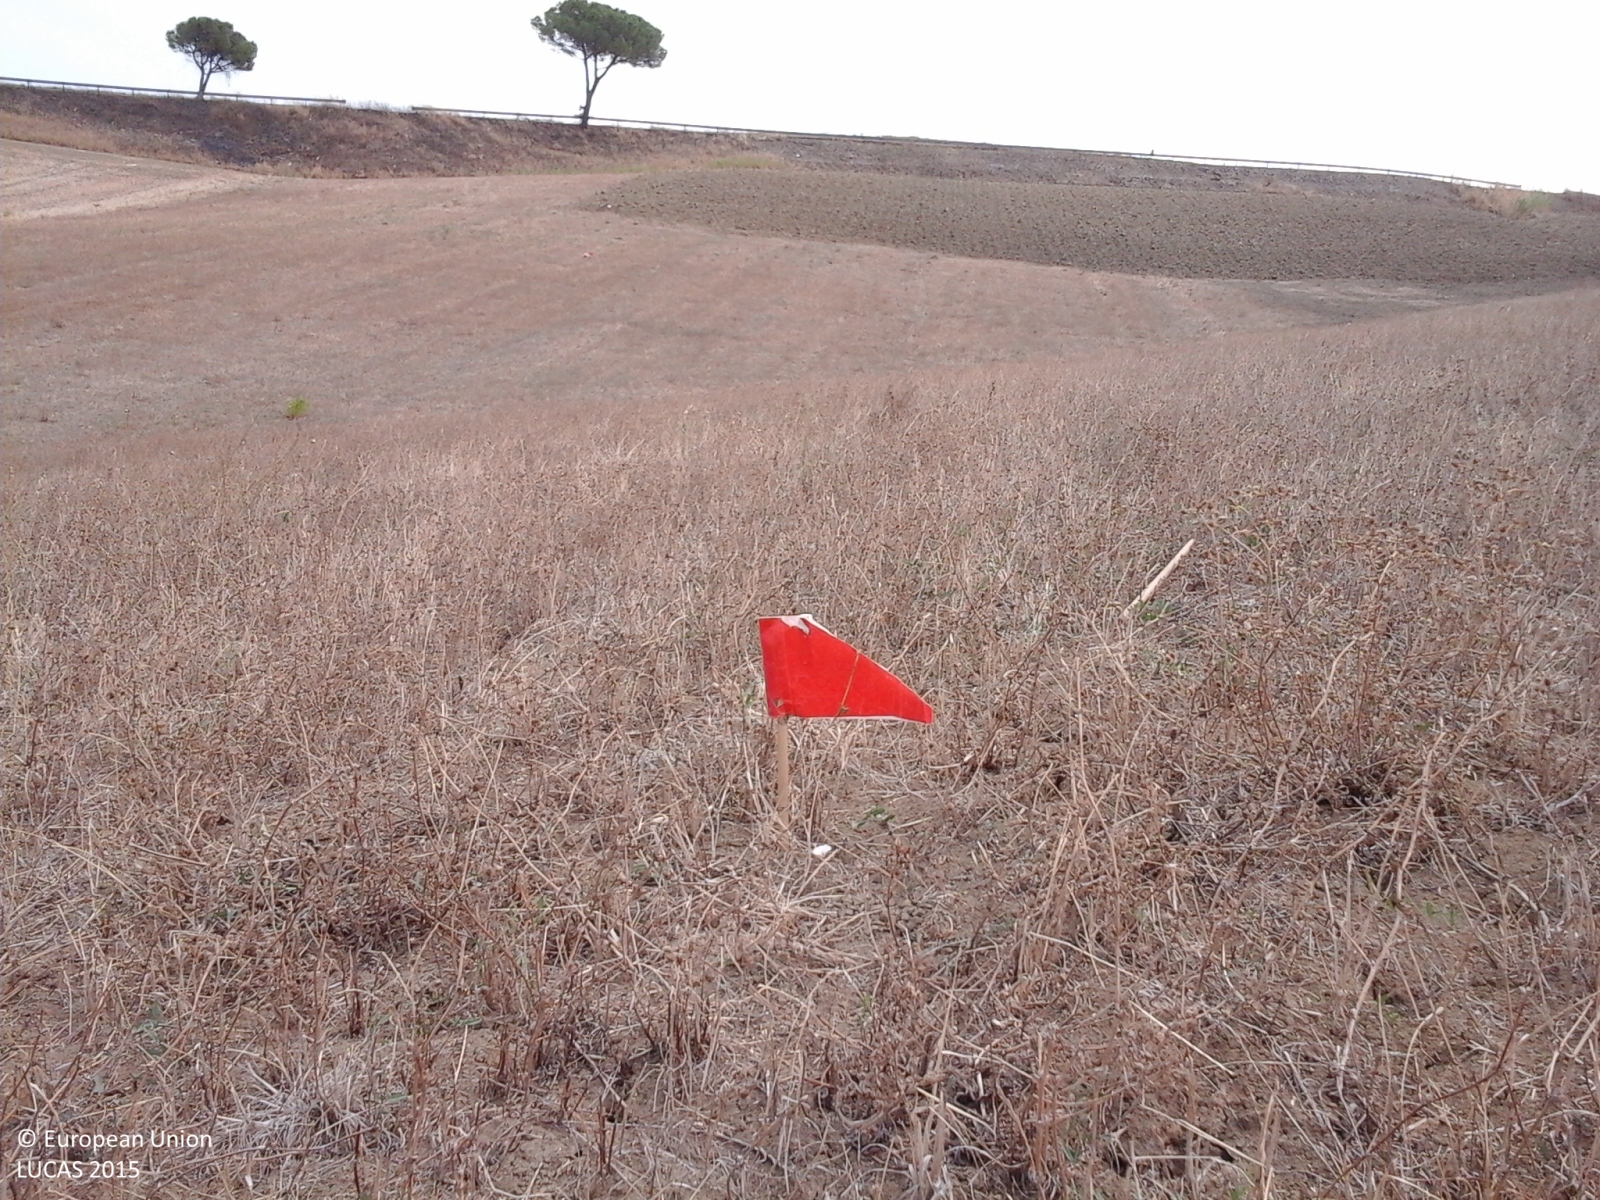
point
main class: Cropland
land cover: Temporary grasslands
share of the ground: > 75 %
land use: Agriculture (excluding fallow land and kitchen gardens)
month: September
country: IT
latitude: 41.8353
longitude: 15.1499
